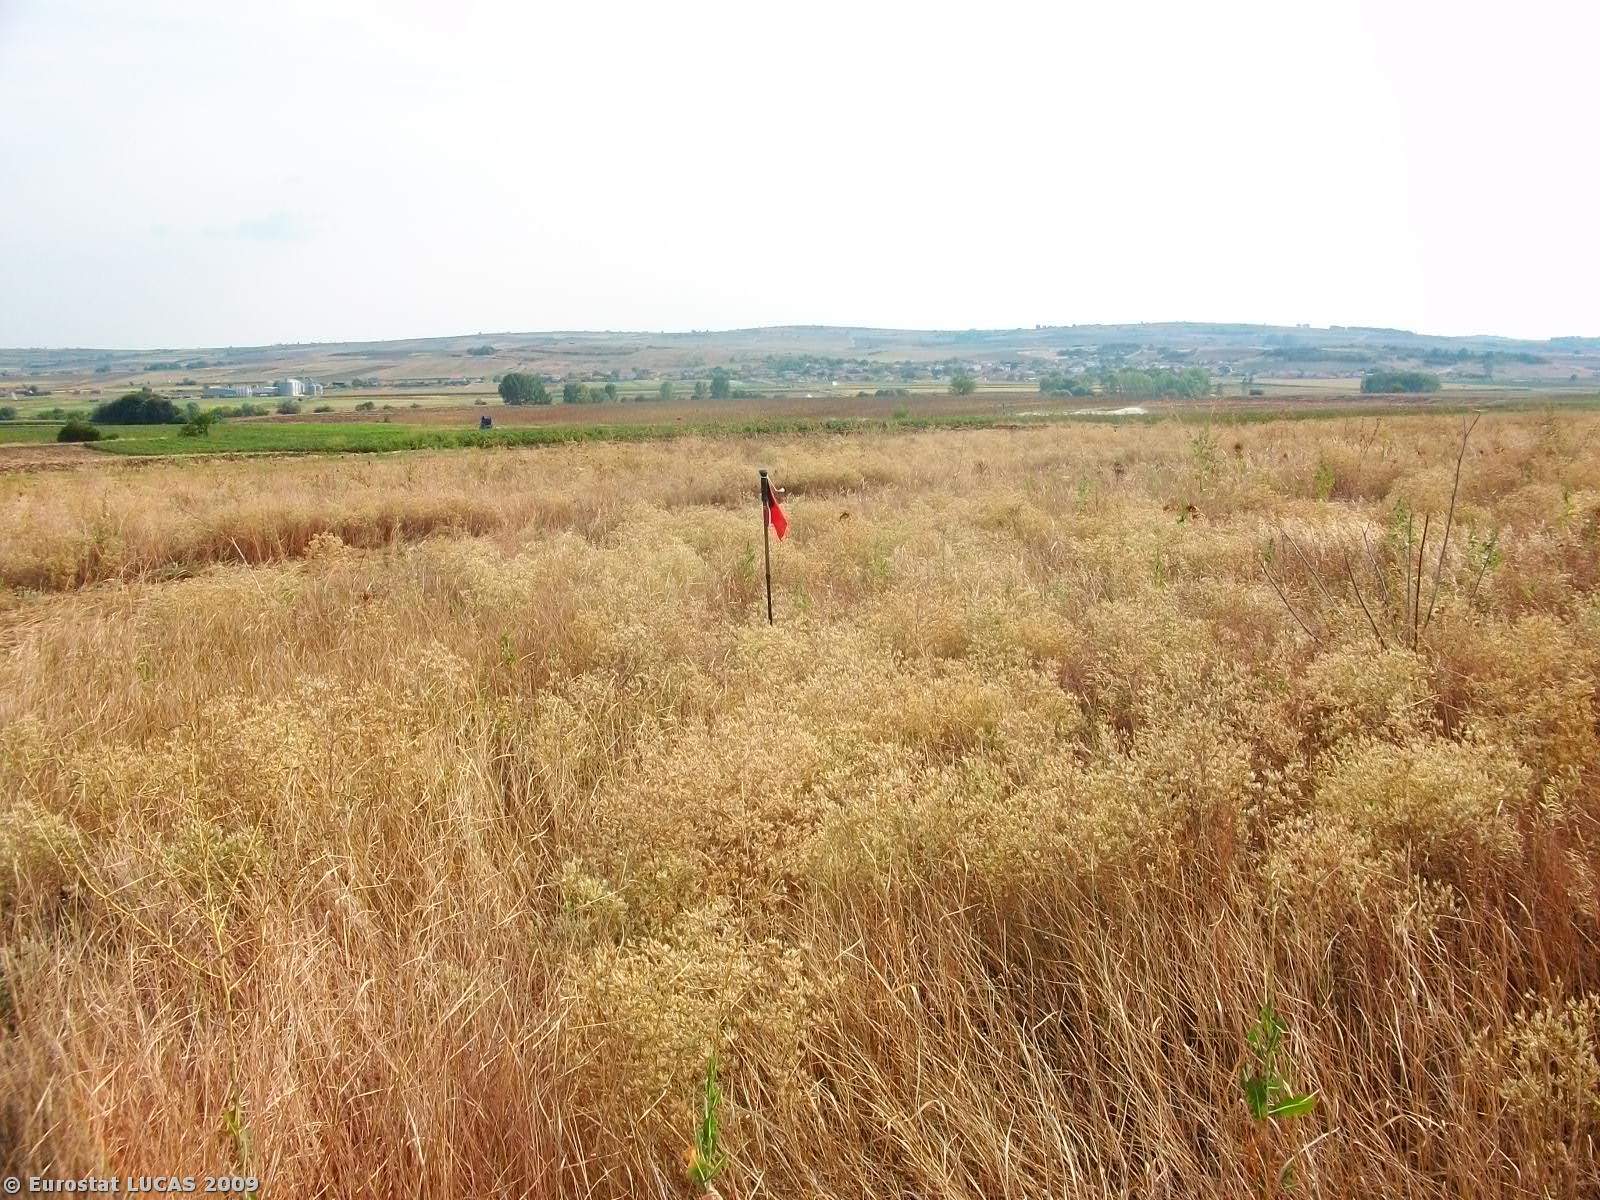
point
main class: Grassland
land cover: Grassland without tree/shrub cover
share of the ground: > 75 %
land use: Unused
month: August
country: GR
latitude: 41.5508
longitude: 26.3694
